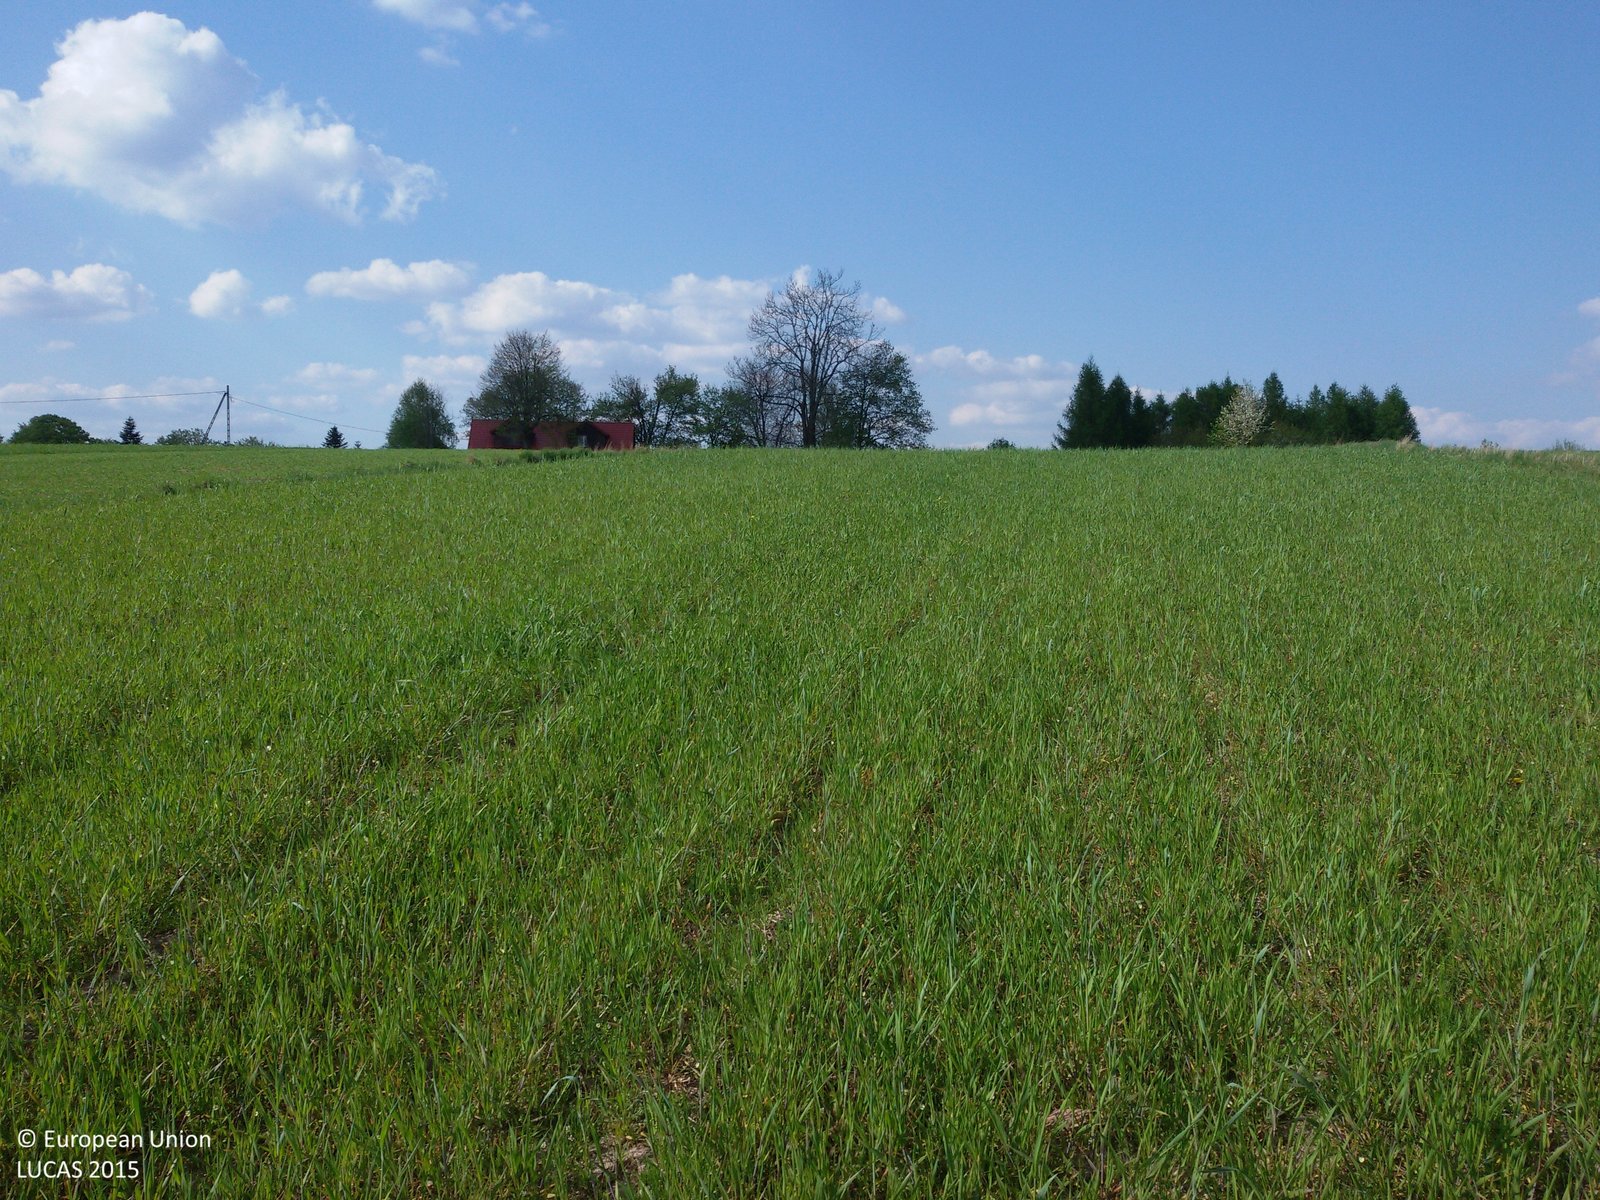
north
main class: Cropland
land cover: Rye
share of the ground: > 75 %
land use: Agriculture (excluding fallow land and kitchen gardens)
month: May
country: PL
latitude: 50.9889
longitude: 20.8555
